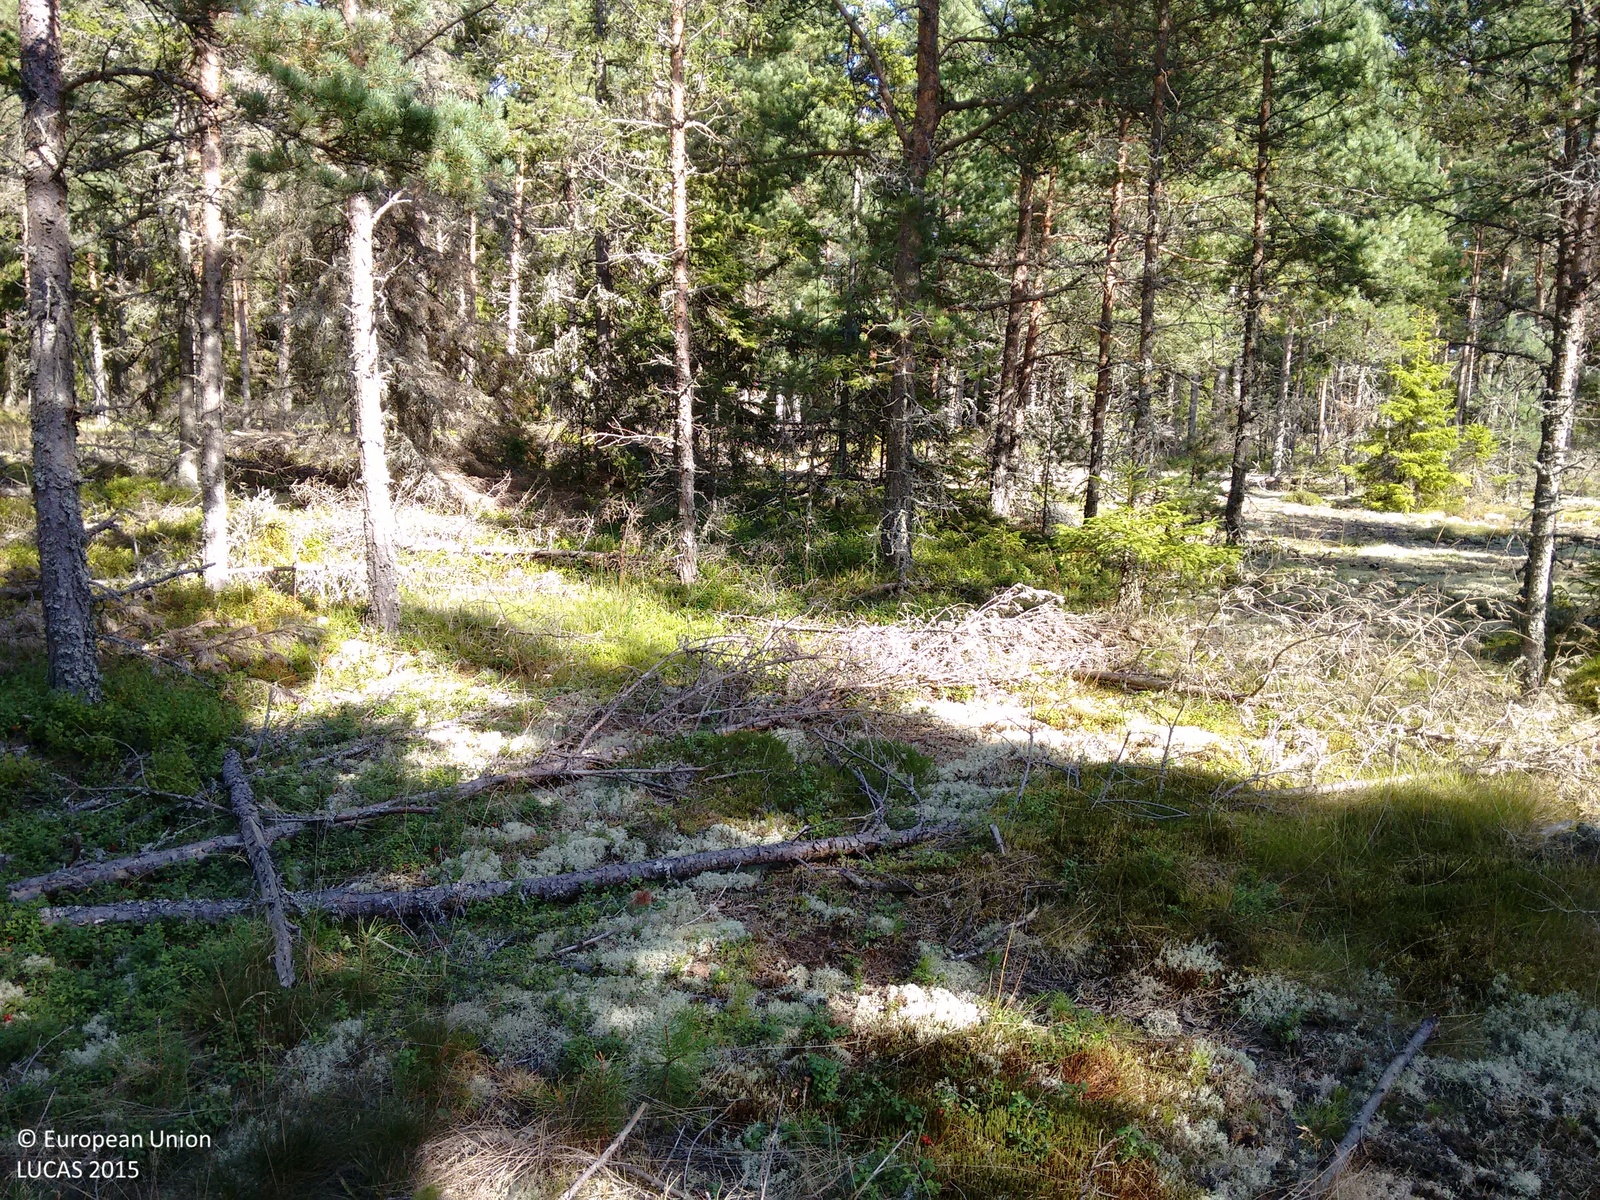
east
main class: Woodland
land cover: Pine dominated coniferous woodland
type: hemiboreal forest and nemoral coniferous forest and mixed broadleaved-coniferous forest
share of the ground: > 75 %
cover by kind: coniferous forest trees 80 %, lichens and mosses 15 %, herbaceous plants 5 %
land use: Forestry
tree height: > 5 m
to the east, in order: Pine dominated coniferous woodland
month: August
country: FI
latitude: 60.2417
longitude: 19.4851
